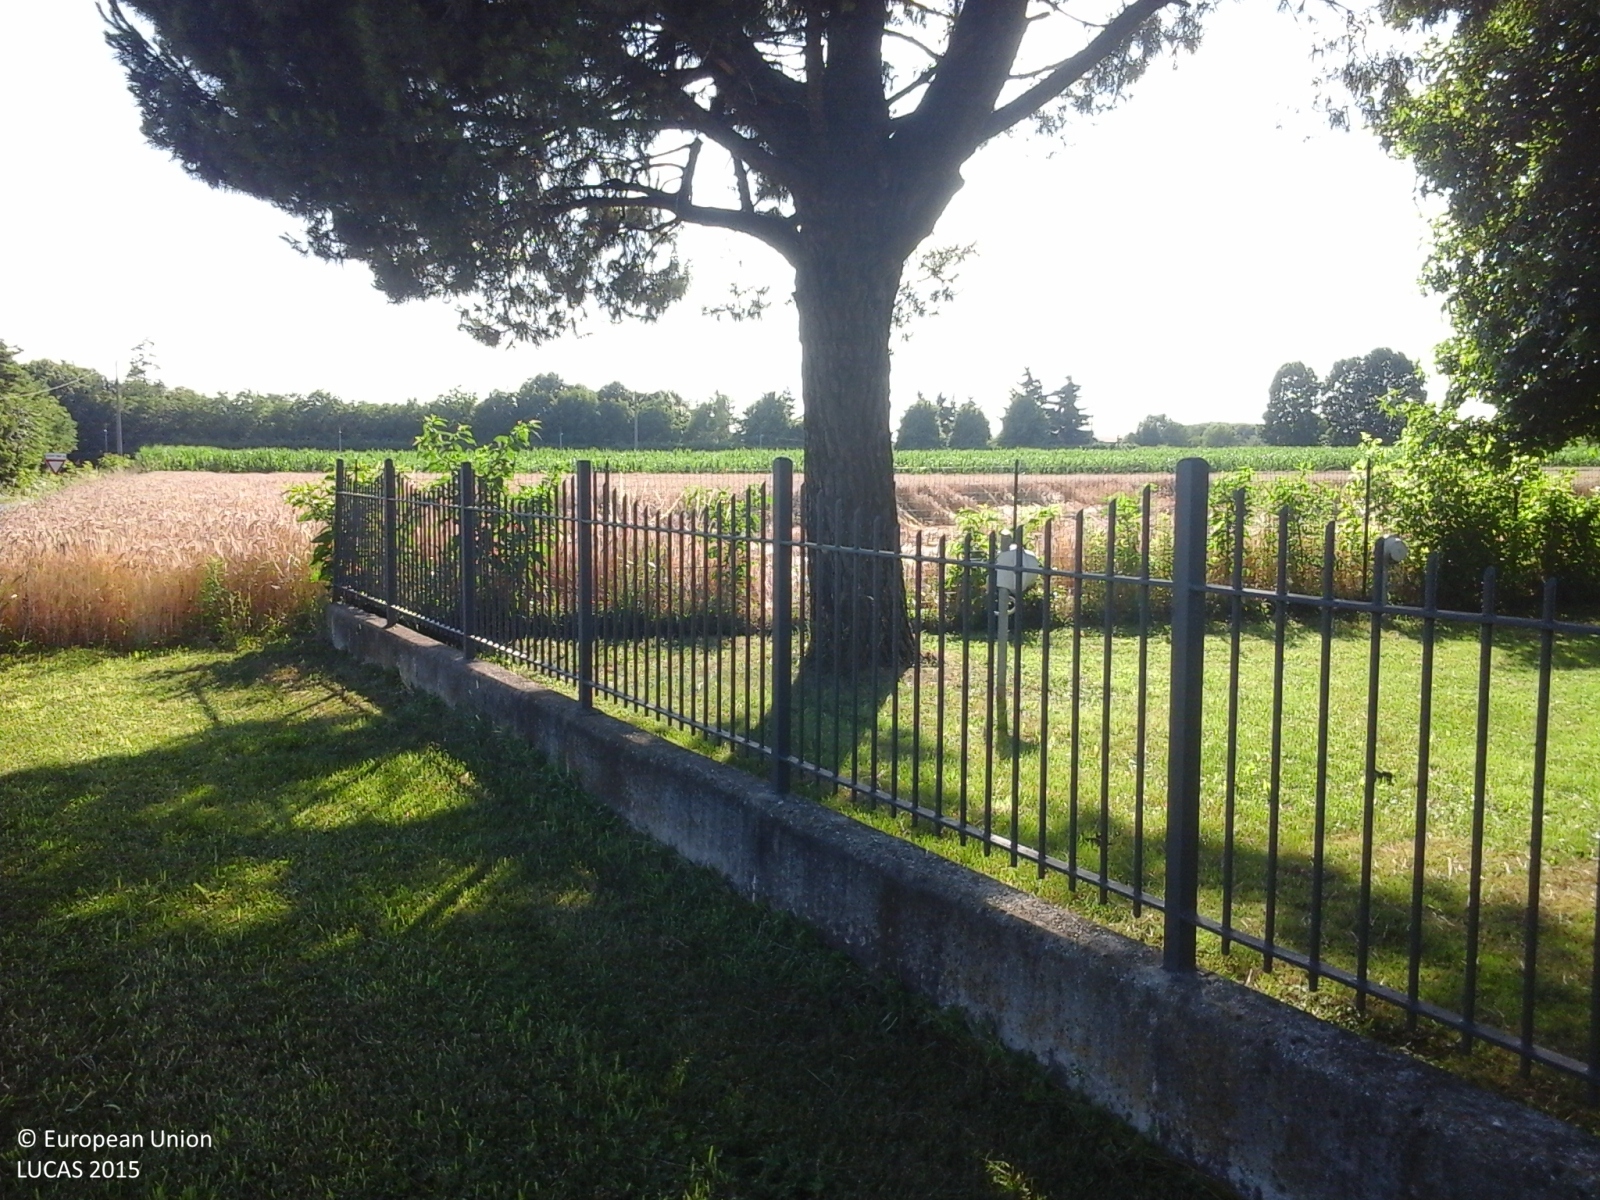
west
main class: Woodland
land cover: Pine dominated coniferous woodland
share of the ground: > 75 %
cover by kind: coniferous forest trees 95 %, herbaceous plants 5 %
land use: Residential
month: June
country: IT
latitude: 45.6459
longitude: 9.2442
